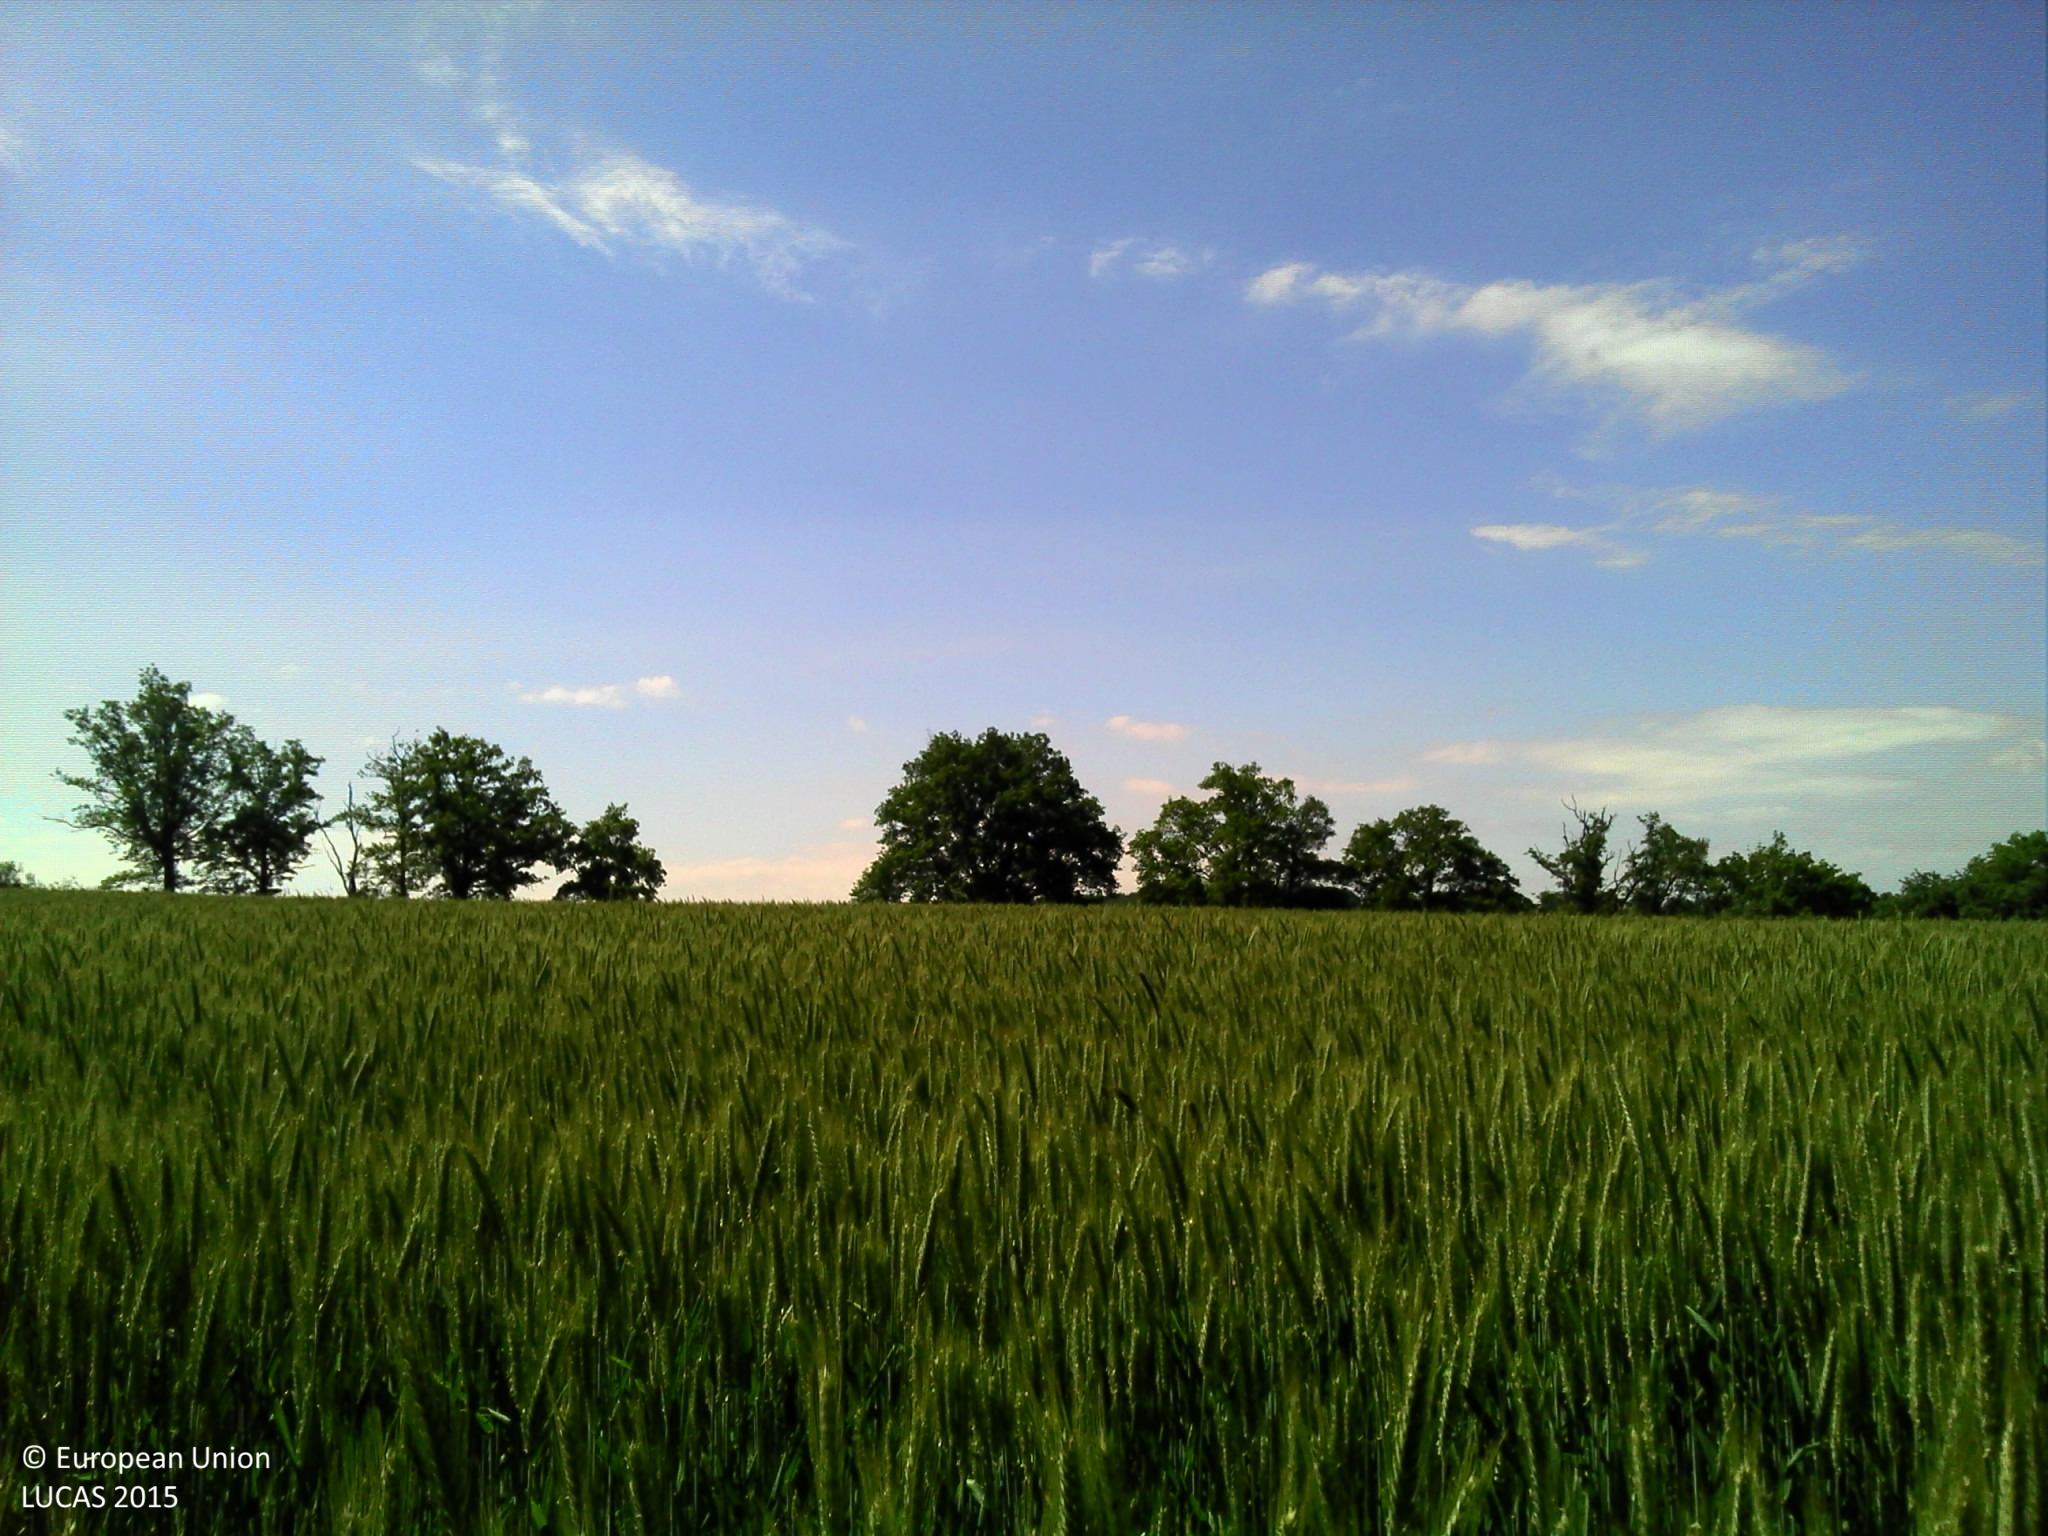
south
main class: Cropland
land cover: Rye
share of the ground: > 75 %
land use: Agriculture (excluding fallow land and kitchen gardens)
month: May
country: FR
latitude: 46.2691
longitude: 2.7696
